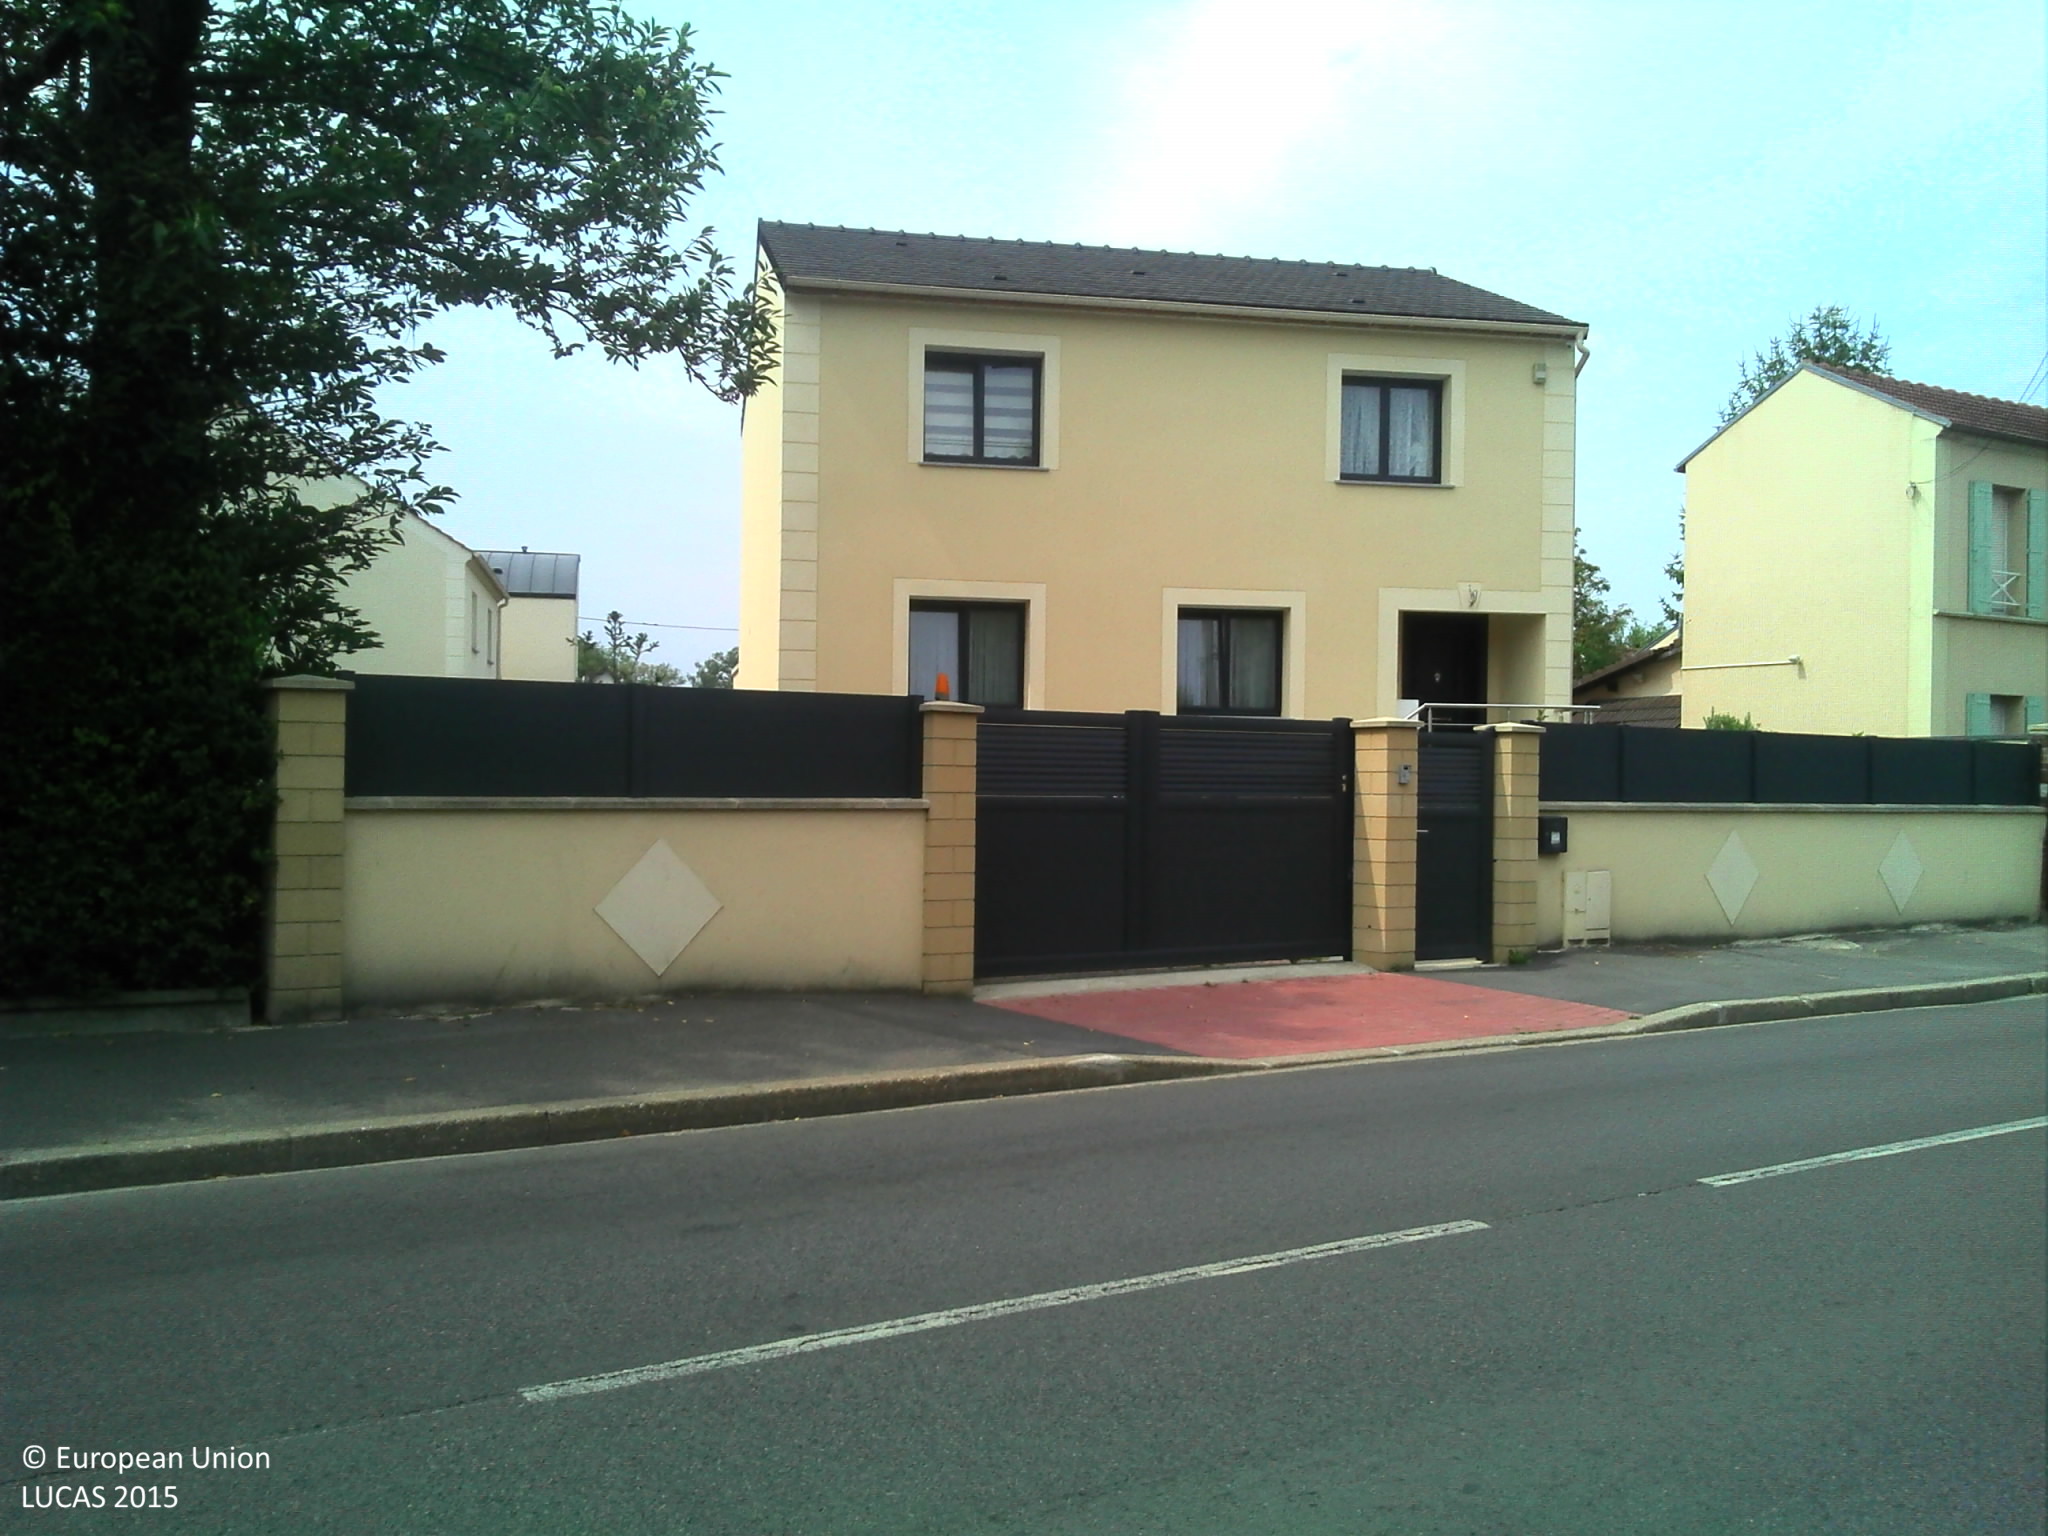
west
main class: Grassland
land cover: Grassland with sparse tree/shrub cover
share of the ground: > 75 %
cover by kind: herbaceous plants 80 %, broadleaved forest trees 5 %
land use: Residential
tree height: < 5 m
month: August
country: FR
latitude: 49.0035
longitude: 2.3188
